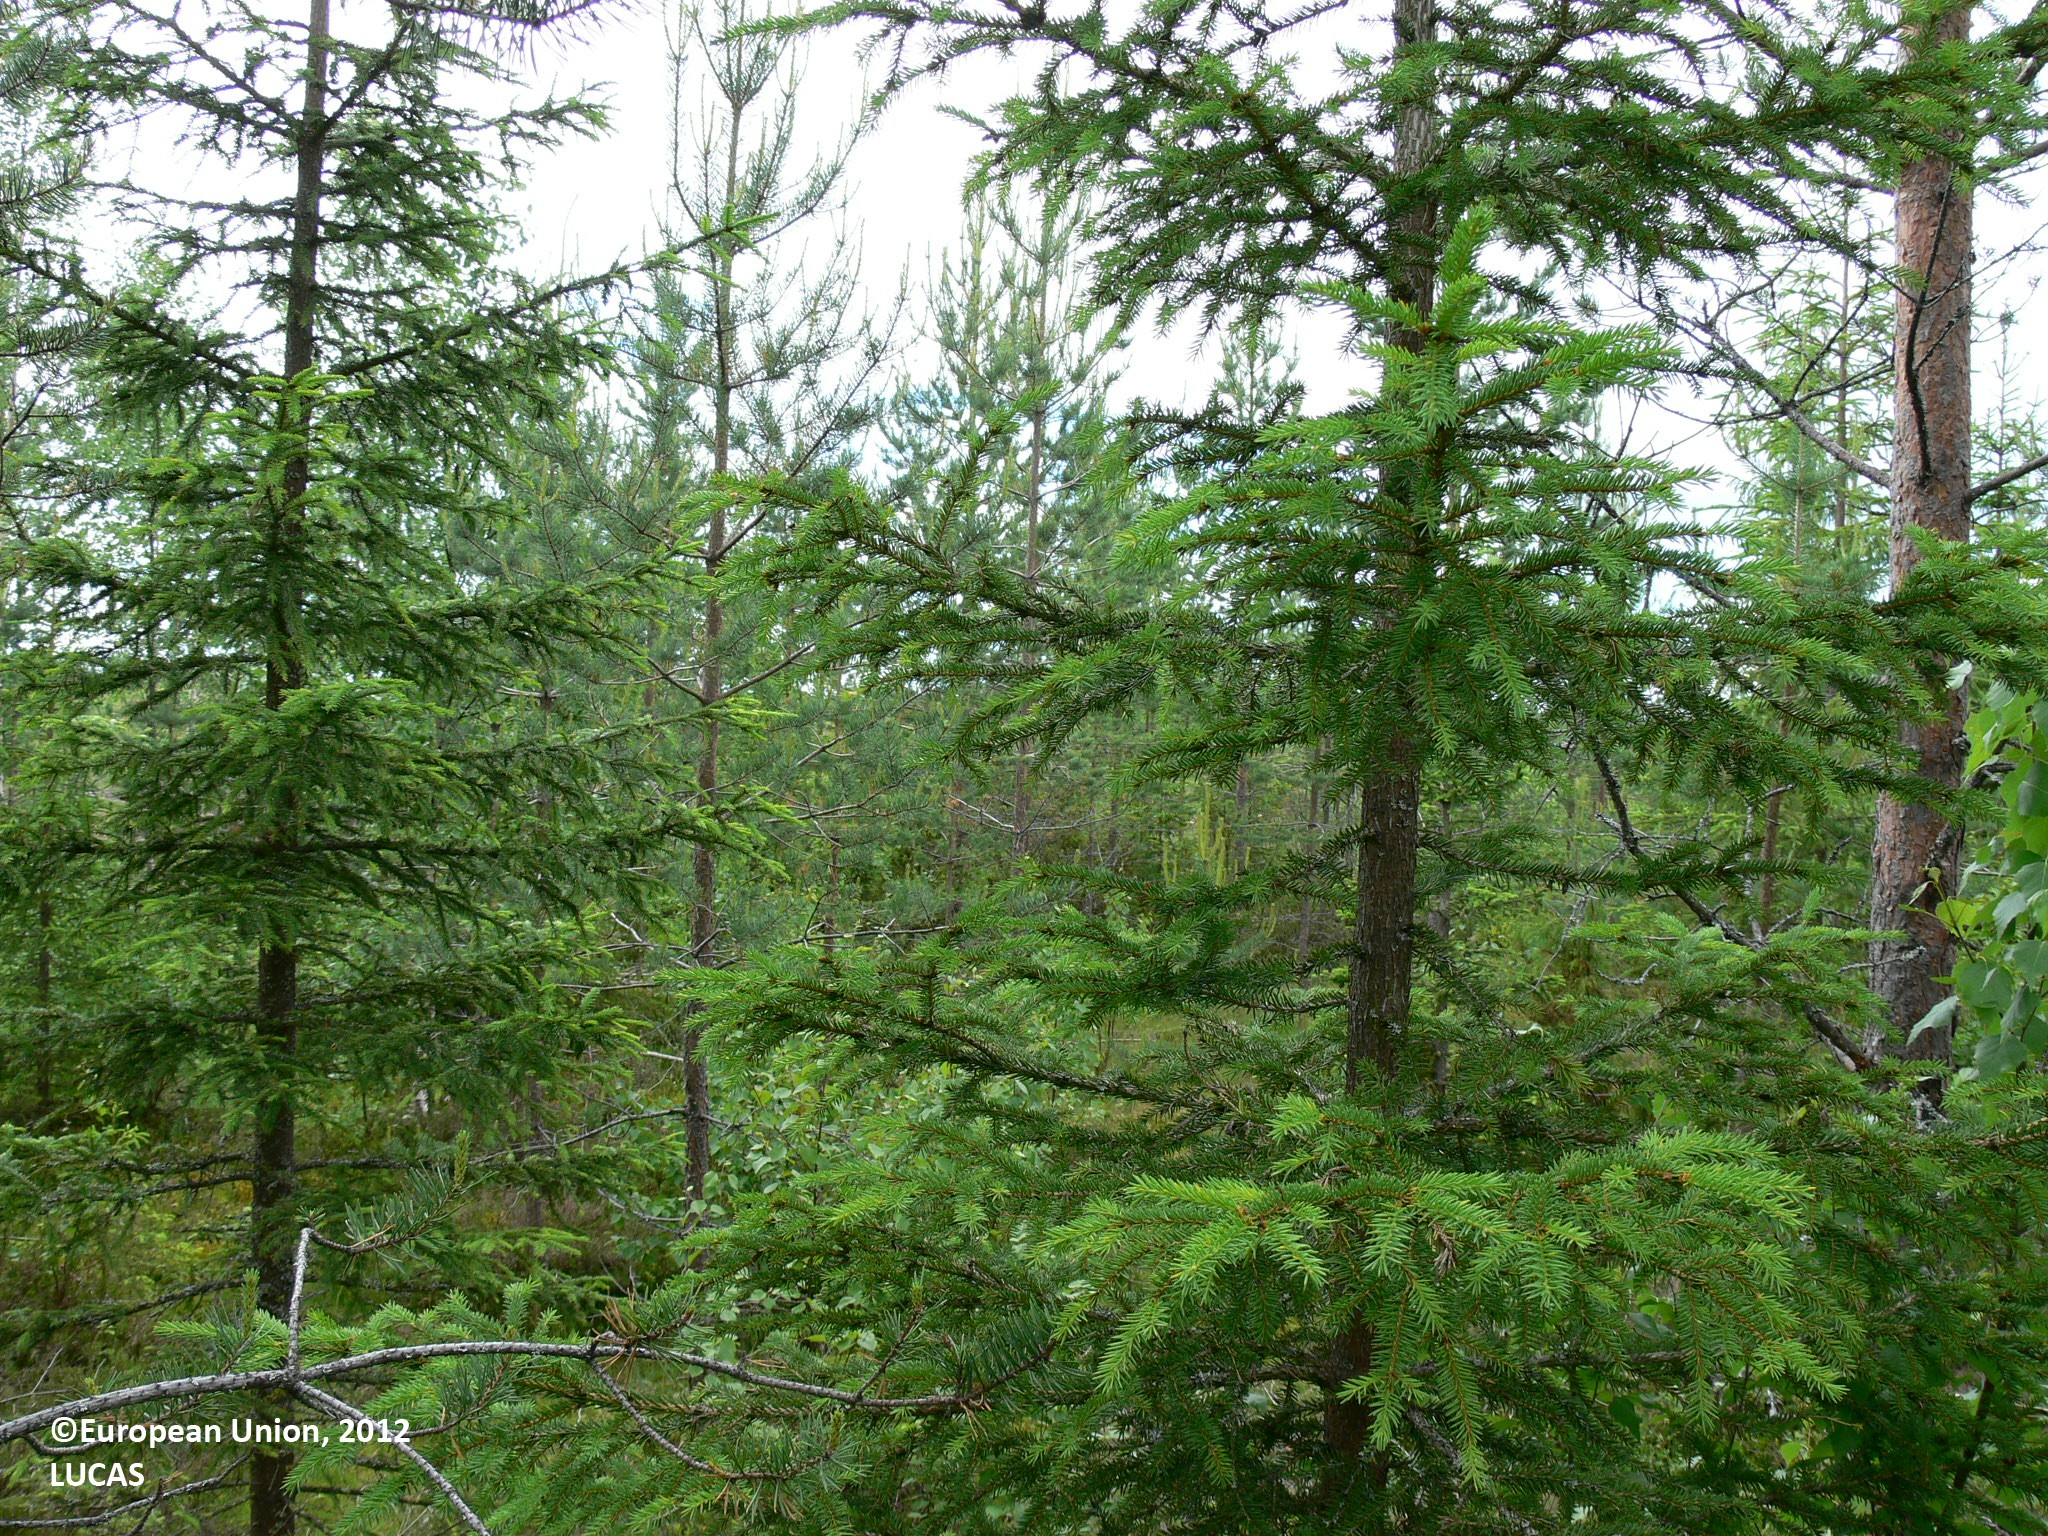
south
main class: Woodland
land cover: Other coniferous woodland
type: boreal forest
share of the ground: > 75 %
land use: Forestry
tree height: < 5 m
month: June
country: FI
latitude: 62.7302
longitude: 30.6522
